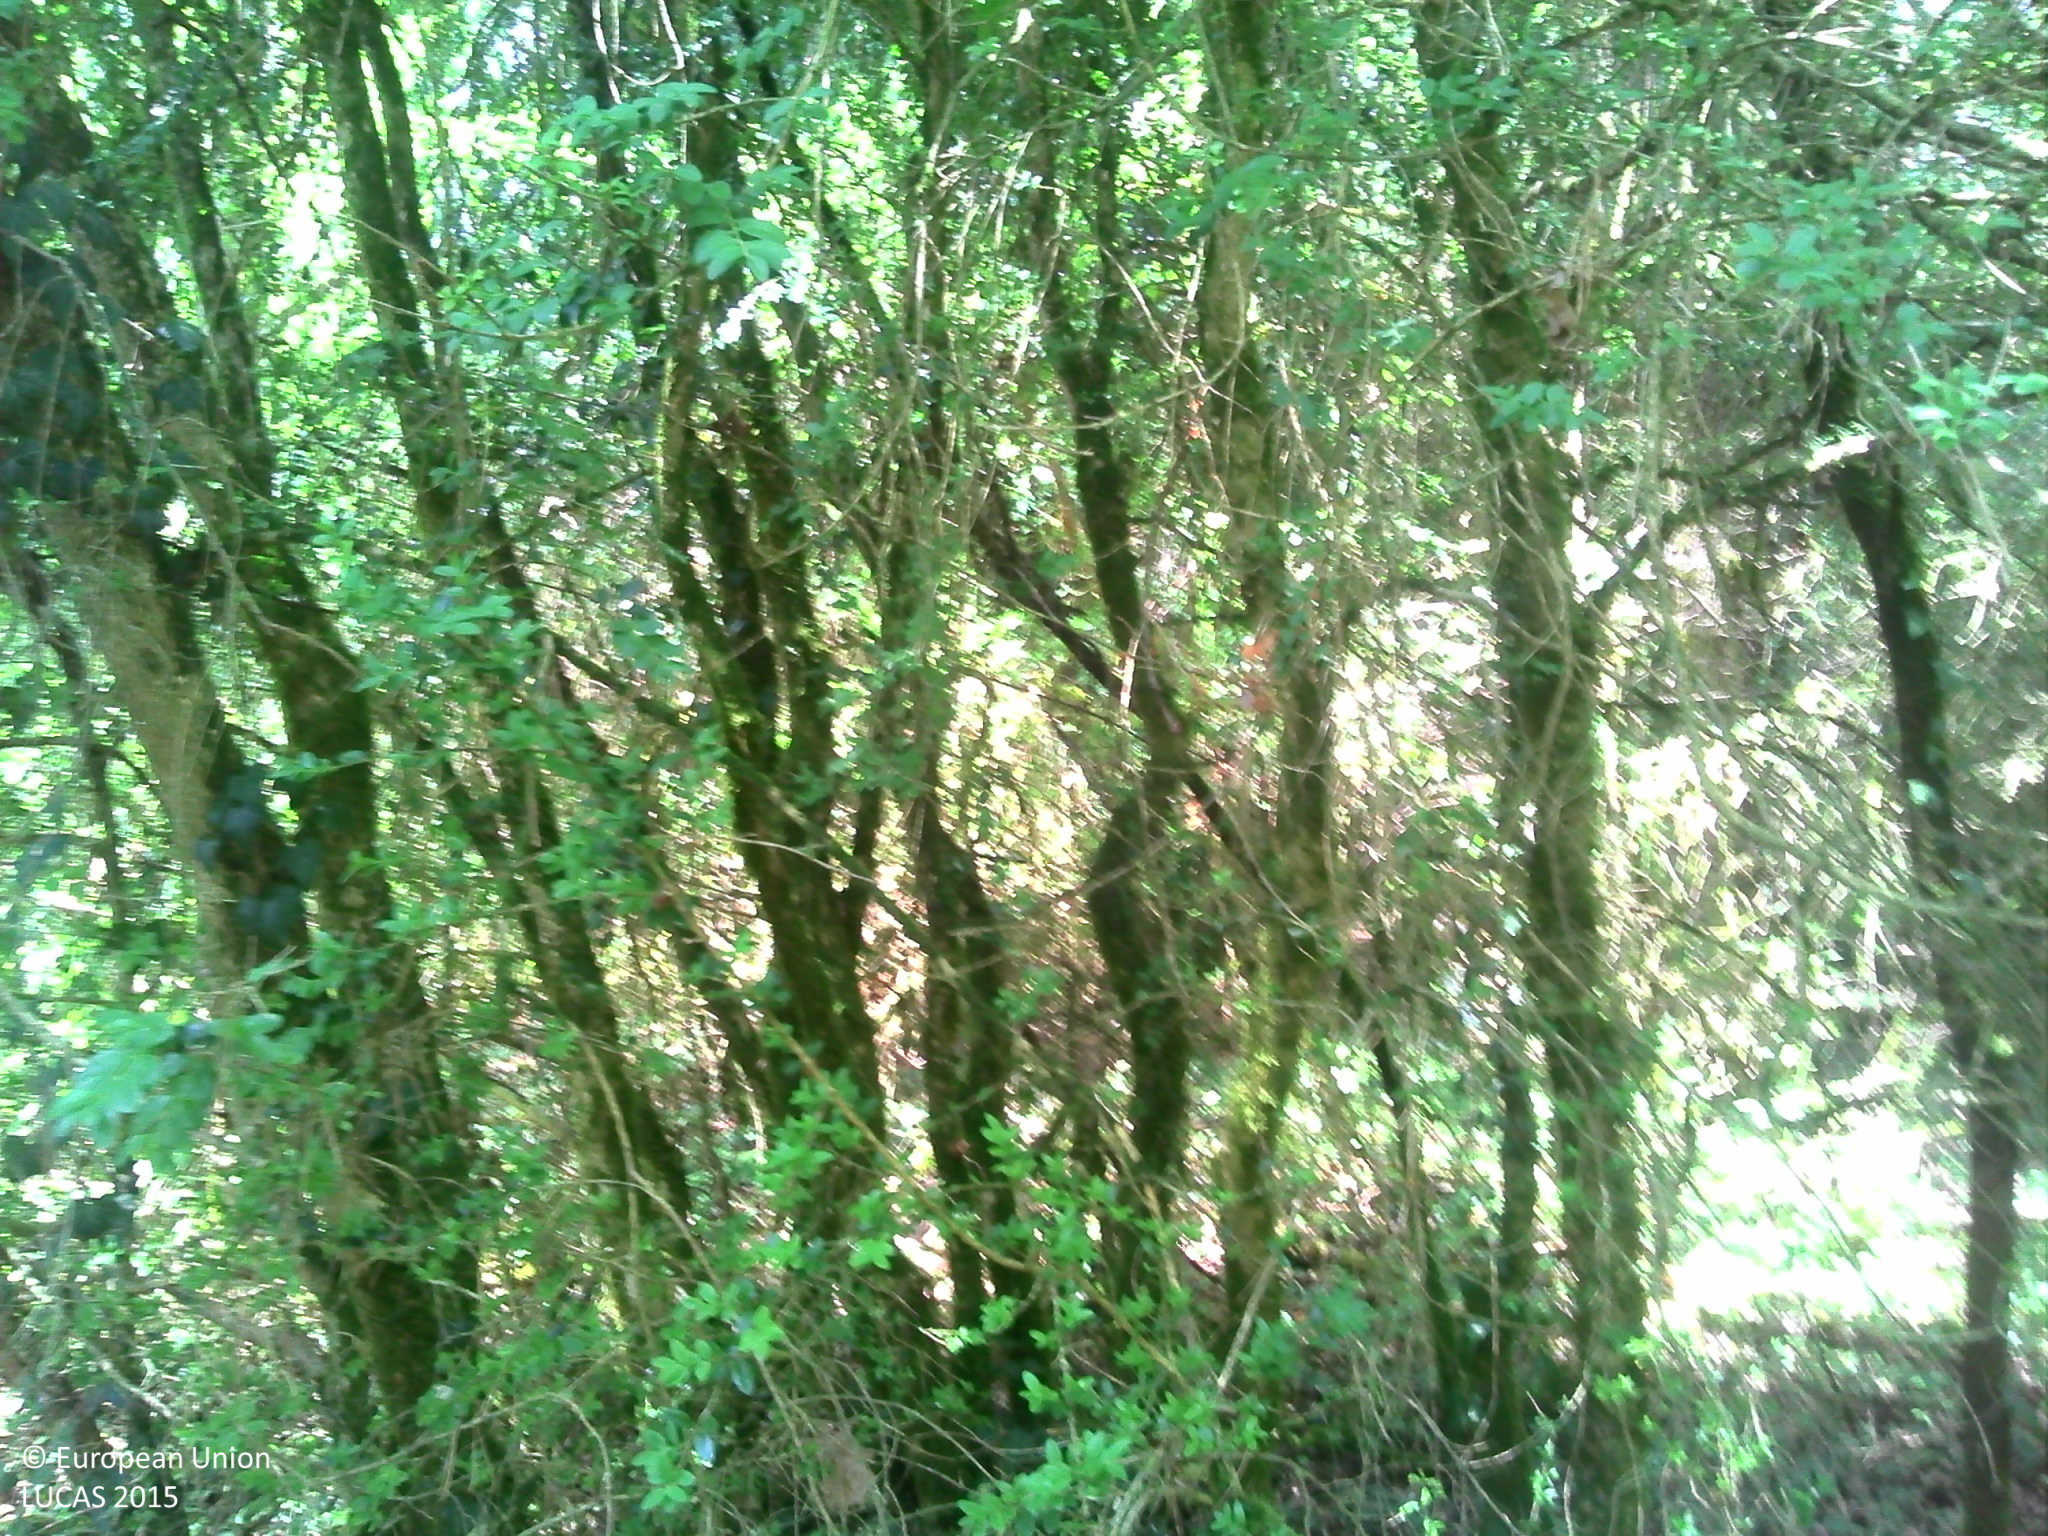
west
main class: Woodland
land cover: Pine dominated mixed woodland
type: hemiboreal forest and nemoral coniferous forest and mixed broadleaved-coniferous forest
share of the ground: > 75 %
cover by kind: coniferous forest trees 30 %, broadleaved forest trees 30 %, herbaceous plants 25 %, lichens and mosses 10 %, shrubs 5 %
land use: Forestry
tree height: > 5 m
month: July
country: FR
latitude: 46.1246
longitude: 6.2894
